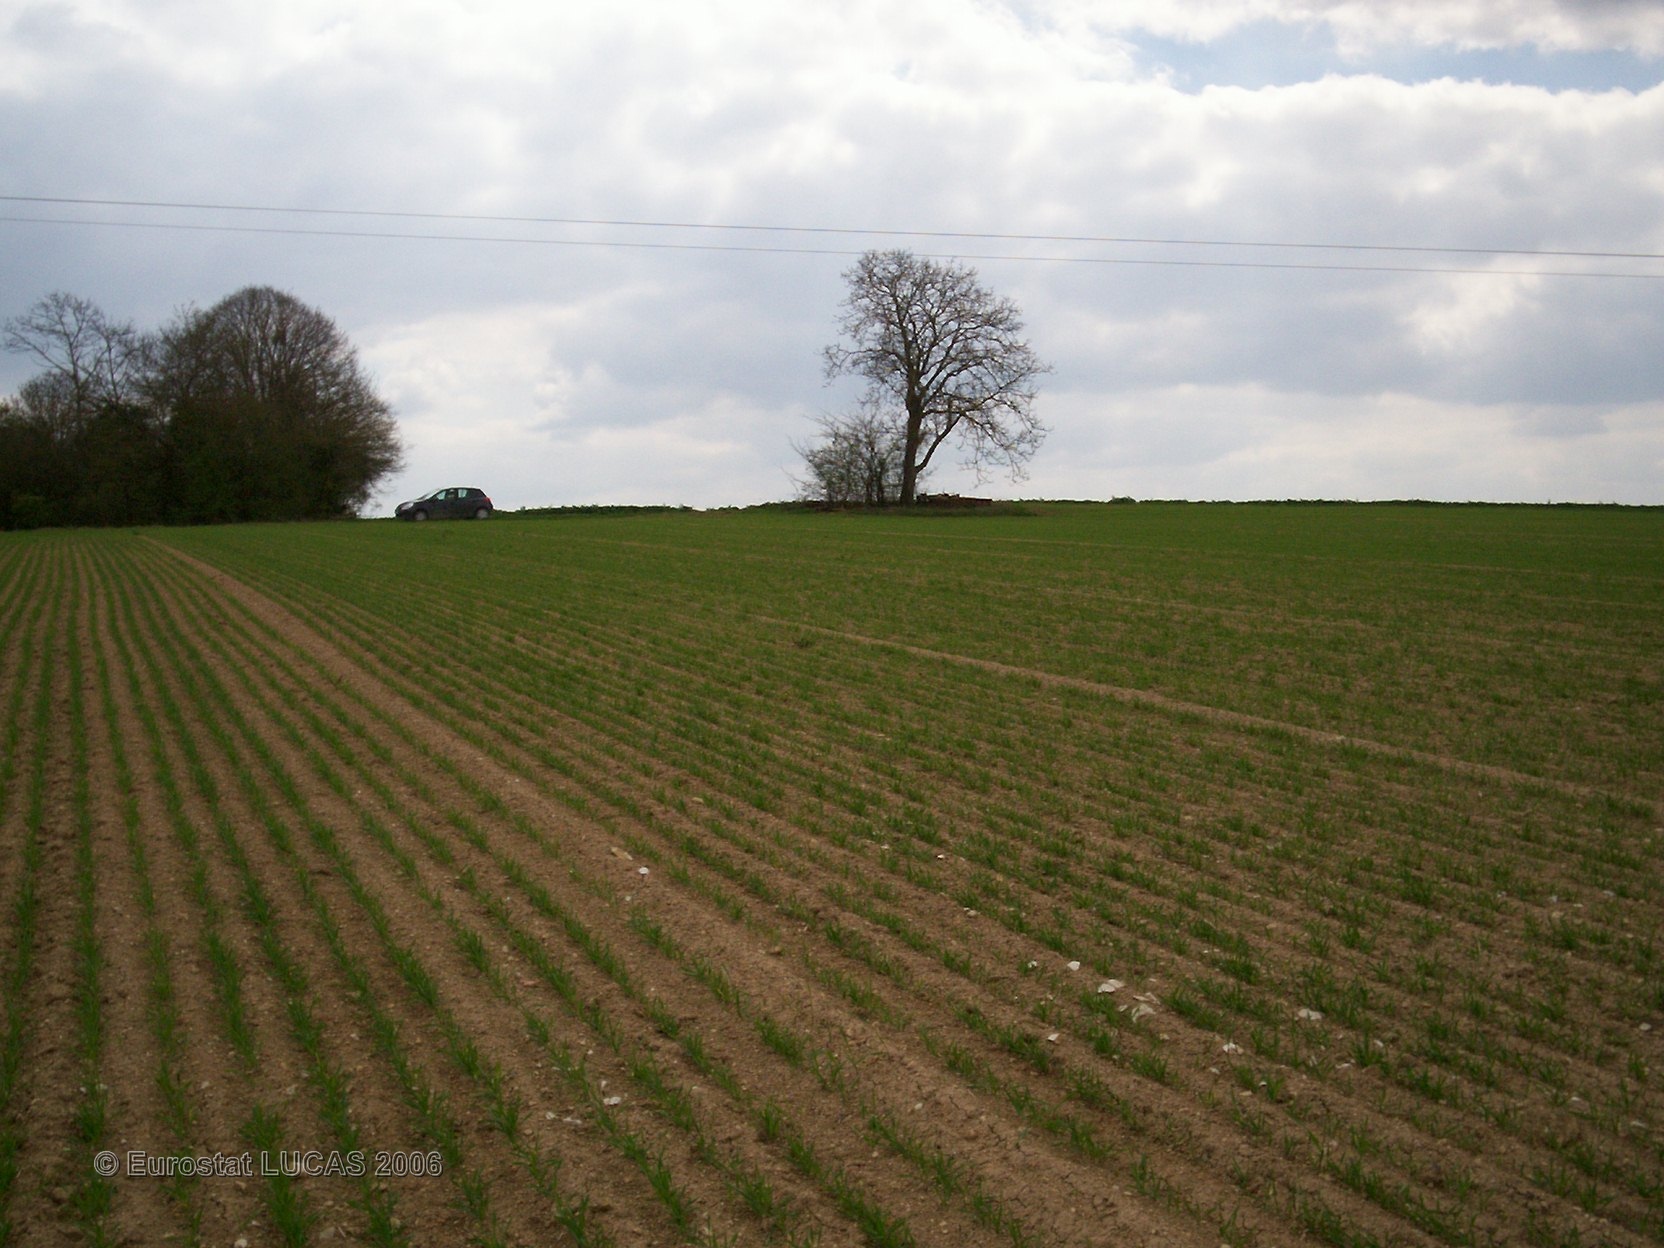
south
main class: Cropland
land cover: Barley
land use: Agriculture (excluding fallow land and kitchen gardens)
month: April
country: FR
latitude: 48.4813
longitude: 4.4639
